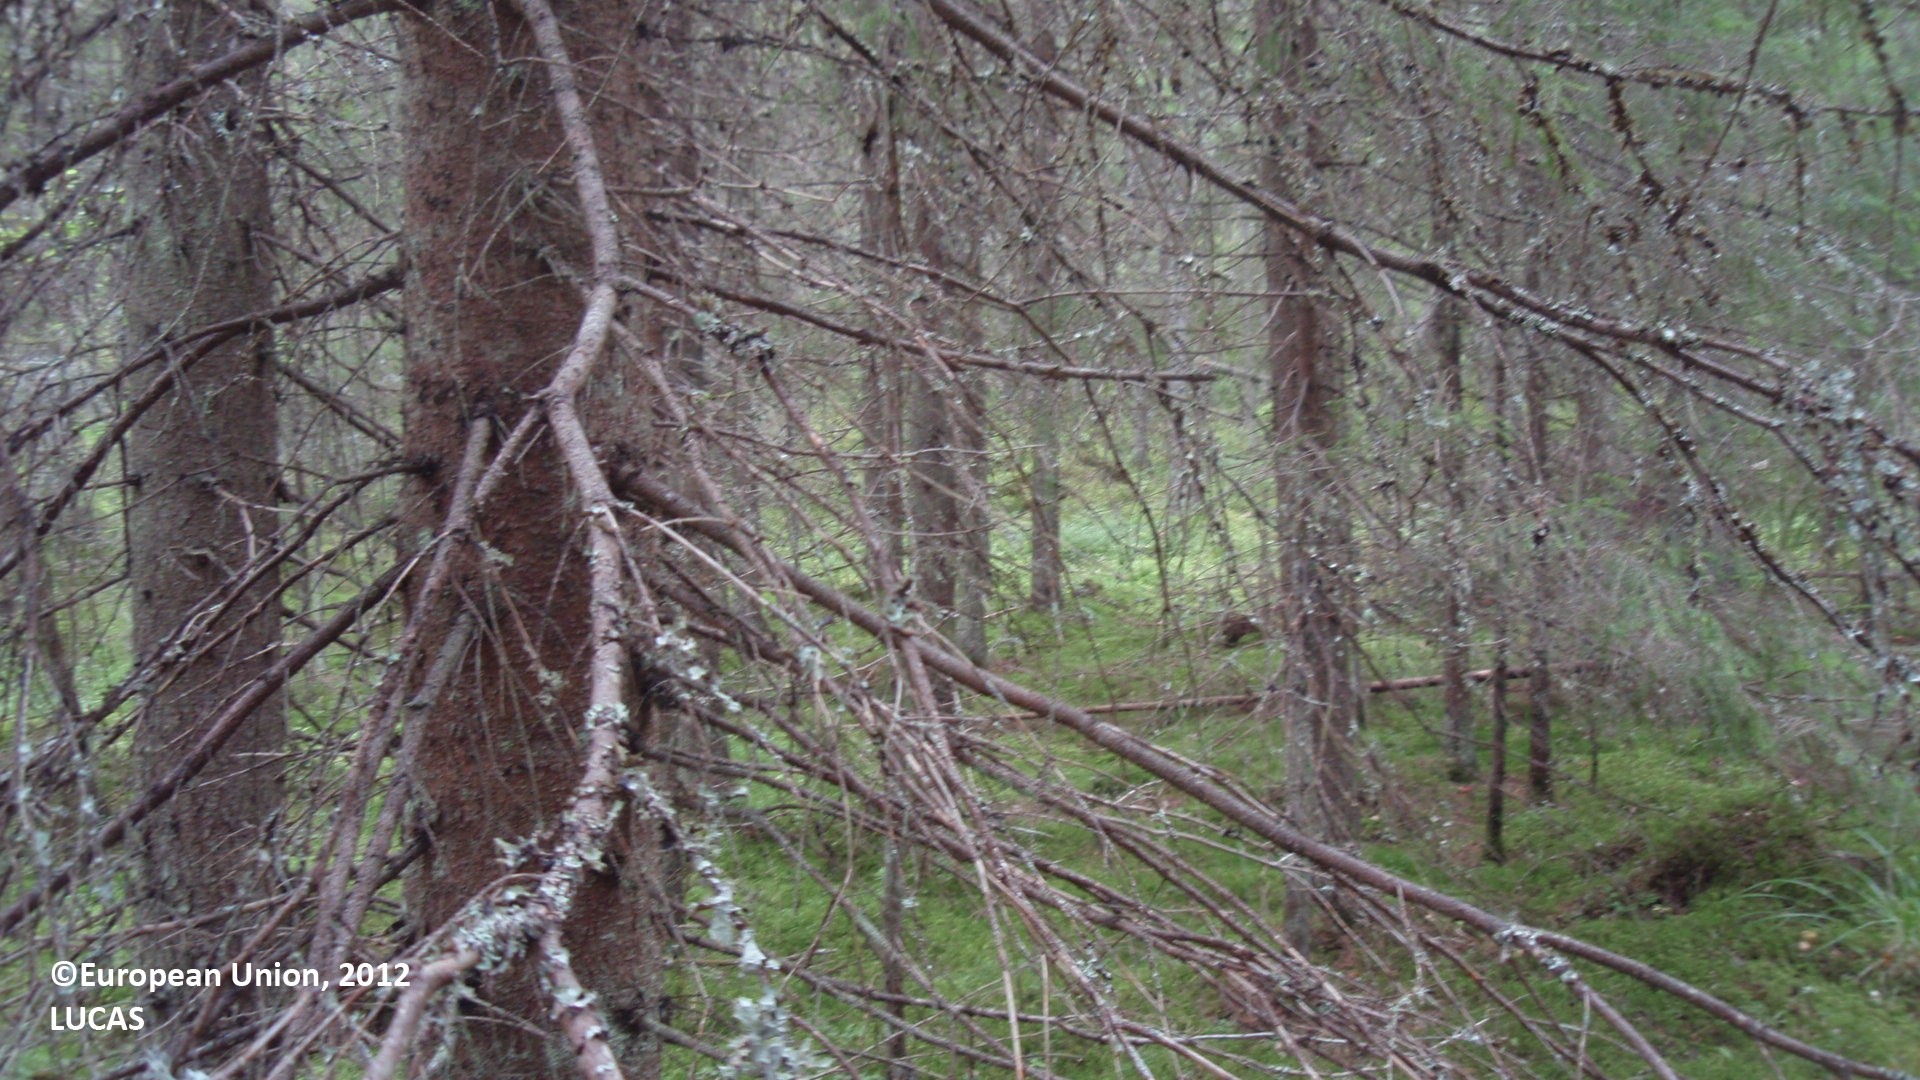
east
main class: Woodland
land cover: Spruce dominated coniferous woodland
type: boreal forest
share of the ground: 50 - 75 %
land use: Forestry
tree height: > 5 m
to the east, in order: Spruce dominated coniferous woodland; Tracks; Pine dominated coniferous woodland; Grass margins; Paved roads, cycling and walking lanes; Grass margins; Pine dominated mixed woodland
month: August
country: FI
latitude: 60.8160
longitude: 27.3313
